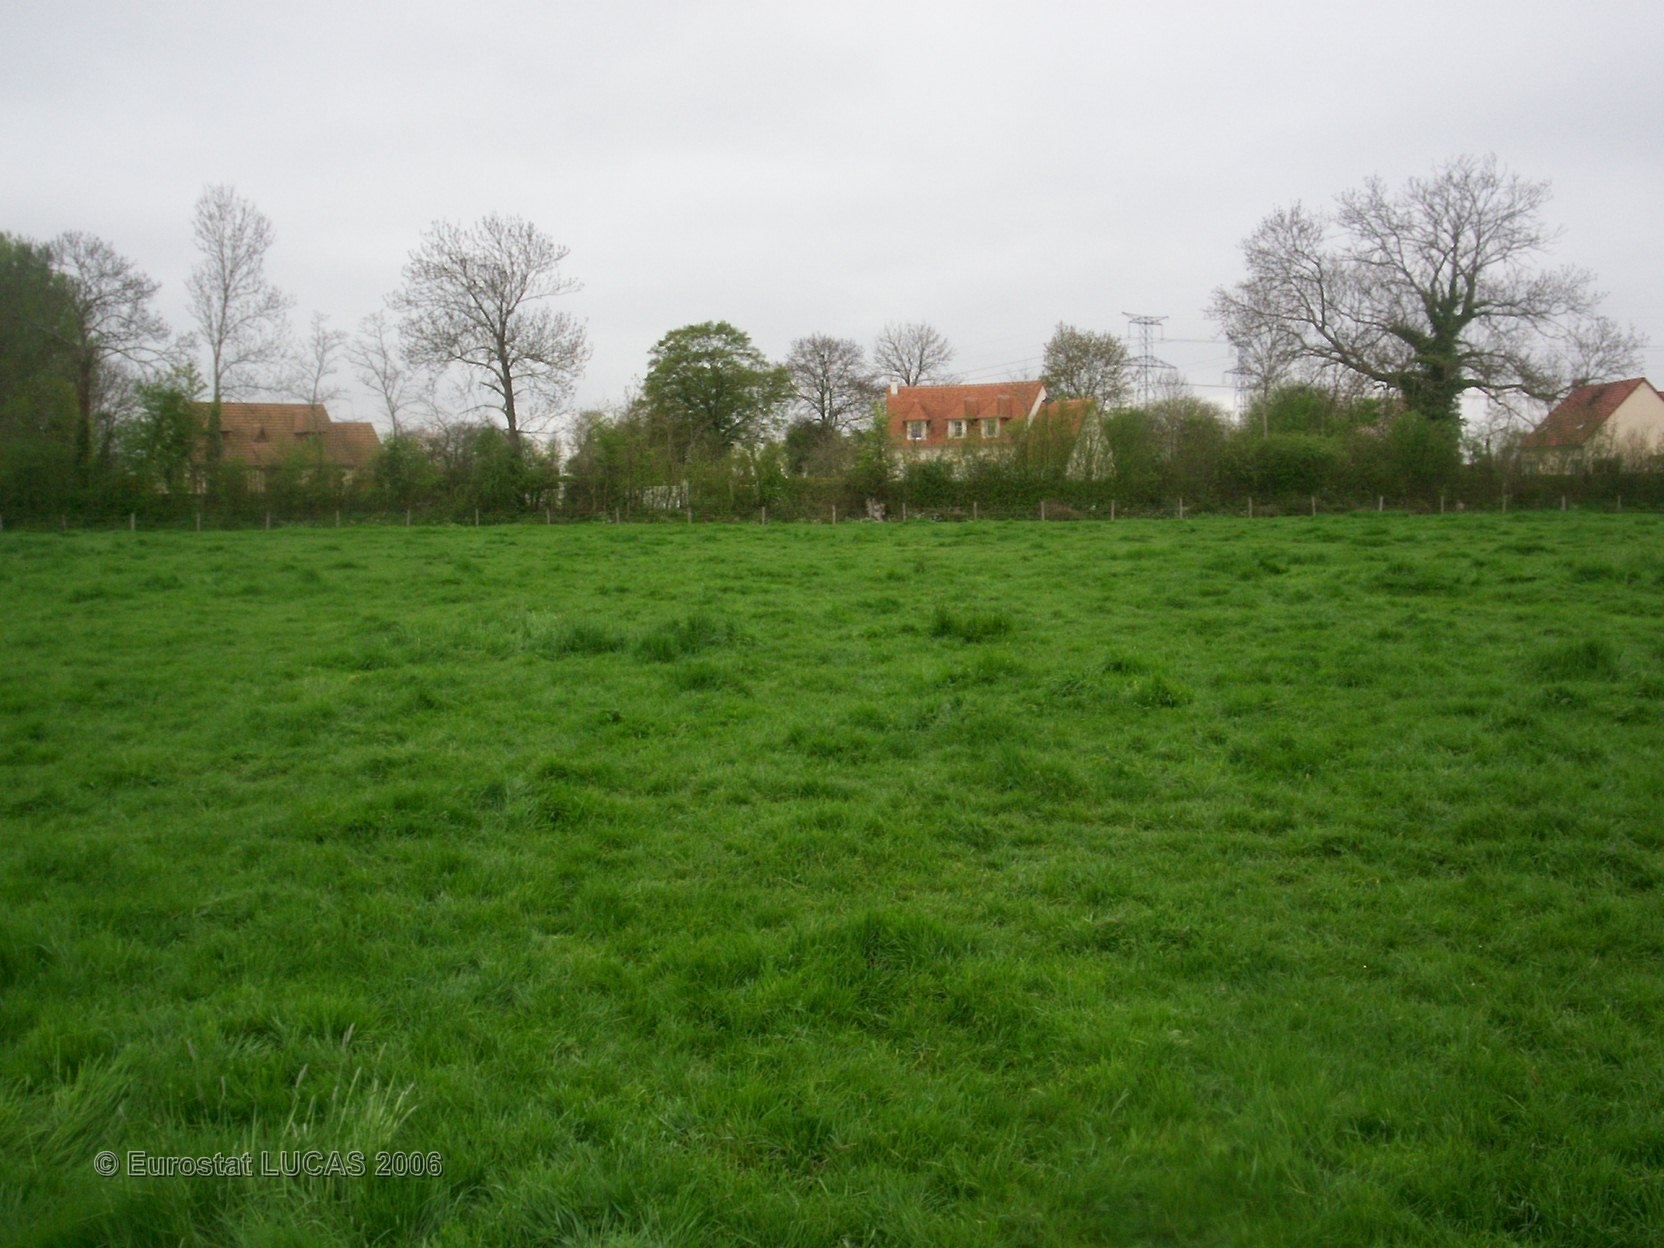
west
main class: Grassland
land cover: Grassland without tree/shrub cover
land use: Agriculture (excluding fallow land and kitchen gardens)
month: April
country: FR
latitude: 49.1537
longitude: -0.1099
